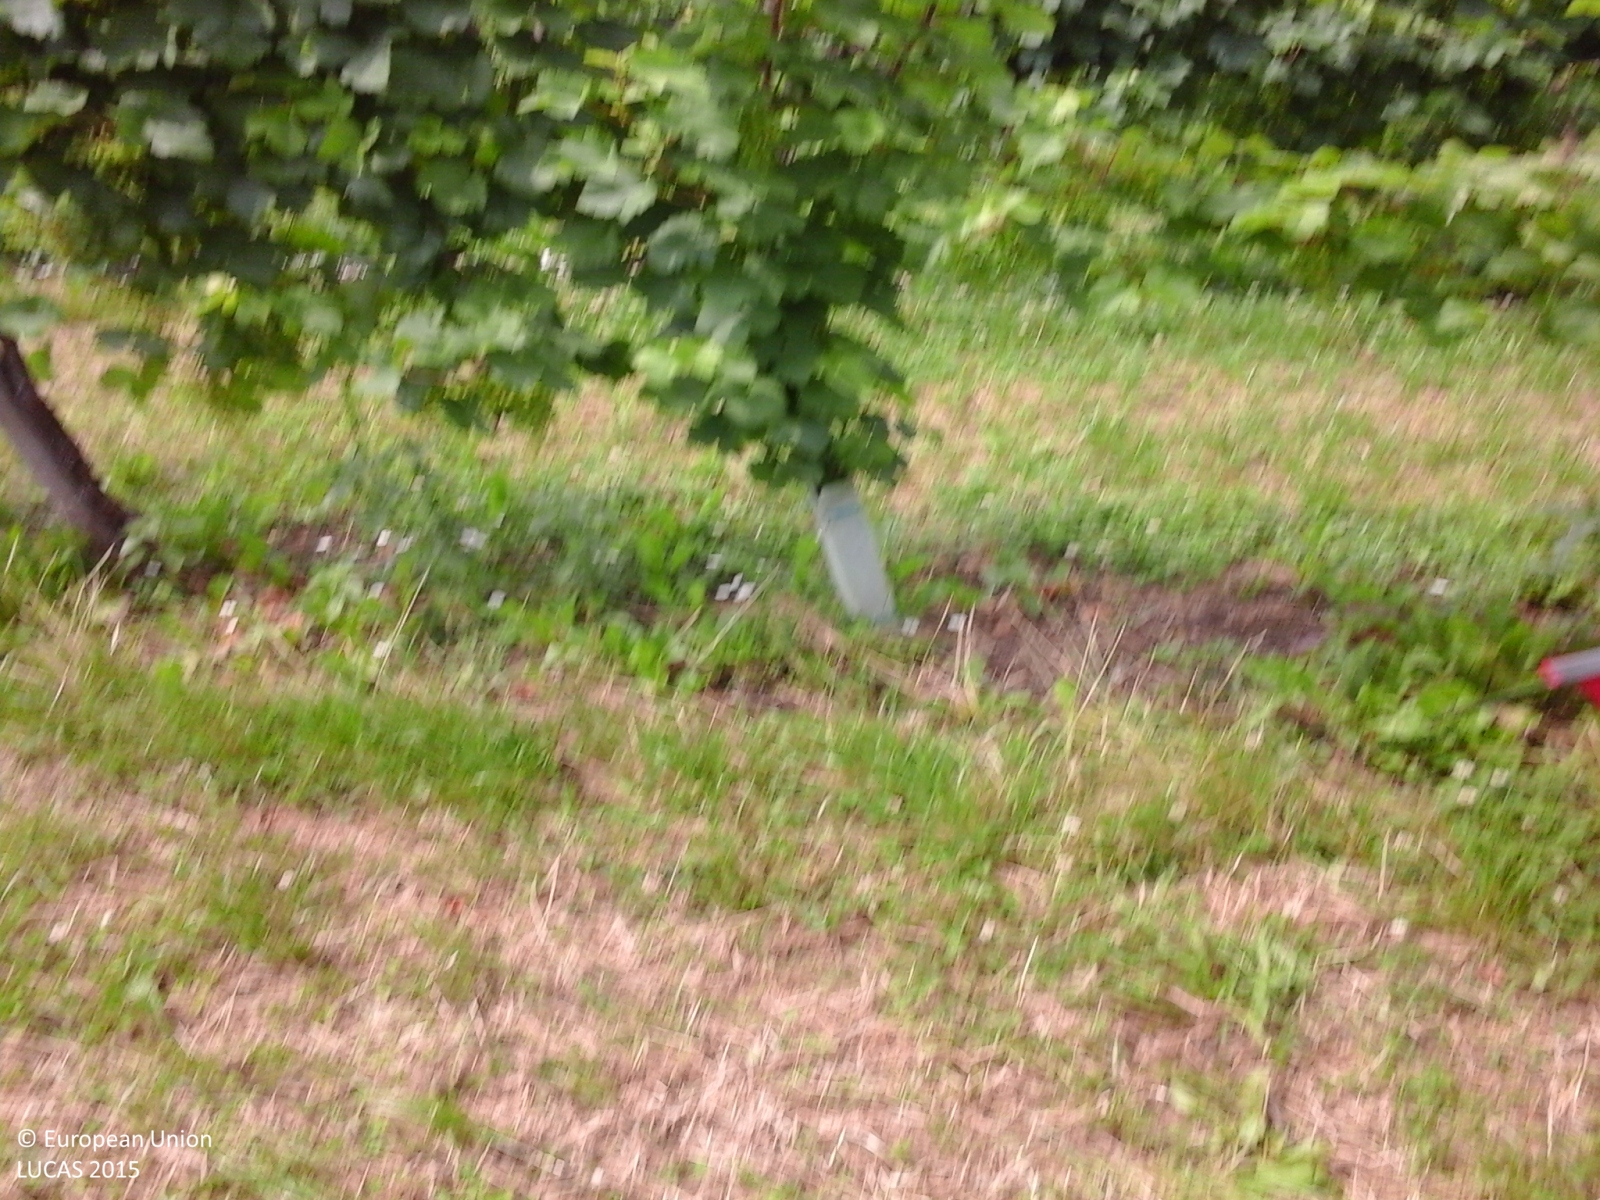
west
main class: Cropland
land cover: Vineyards
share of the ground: 25 - 50 %
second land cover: Grassland without tree/shrub cover
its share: > 75 %
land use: Agriculture (excluding fallow land and kitchen gardens)
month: June
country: IT
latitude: 45.9636
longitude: 12.4099
